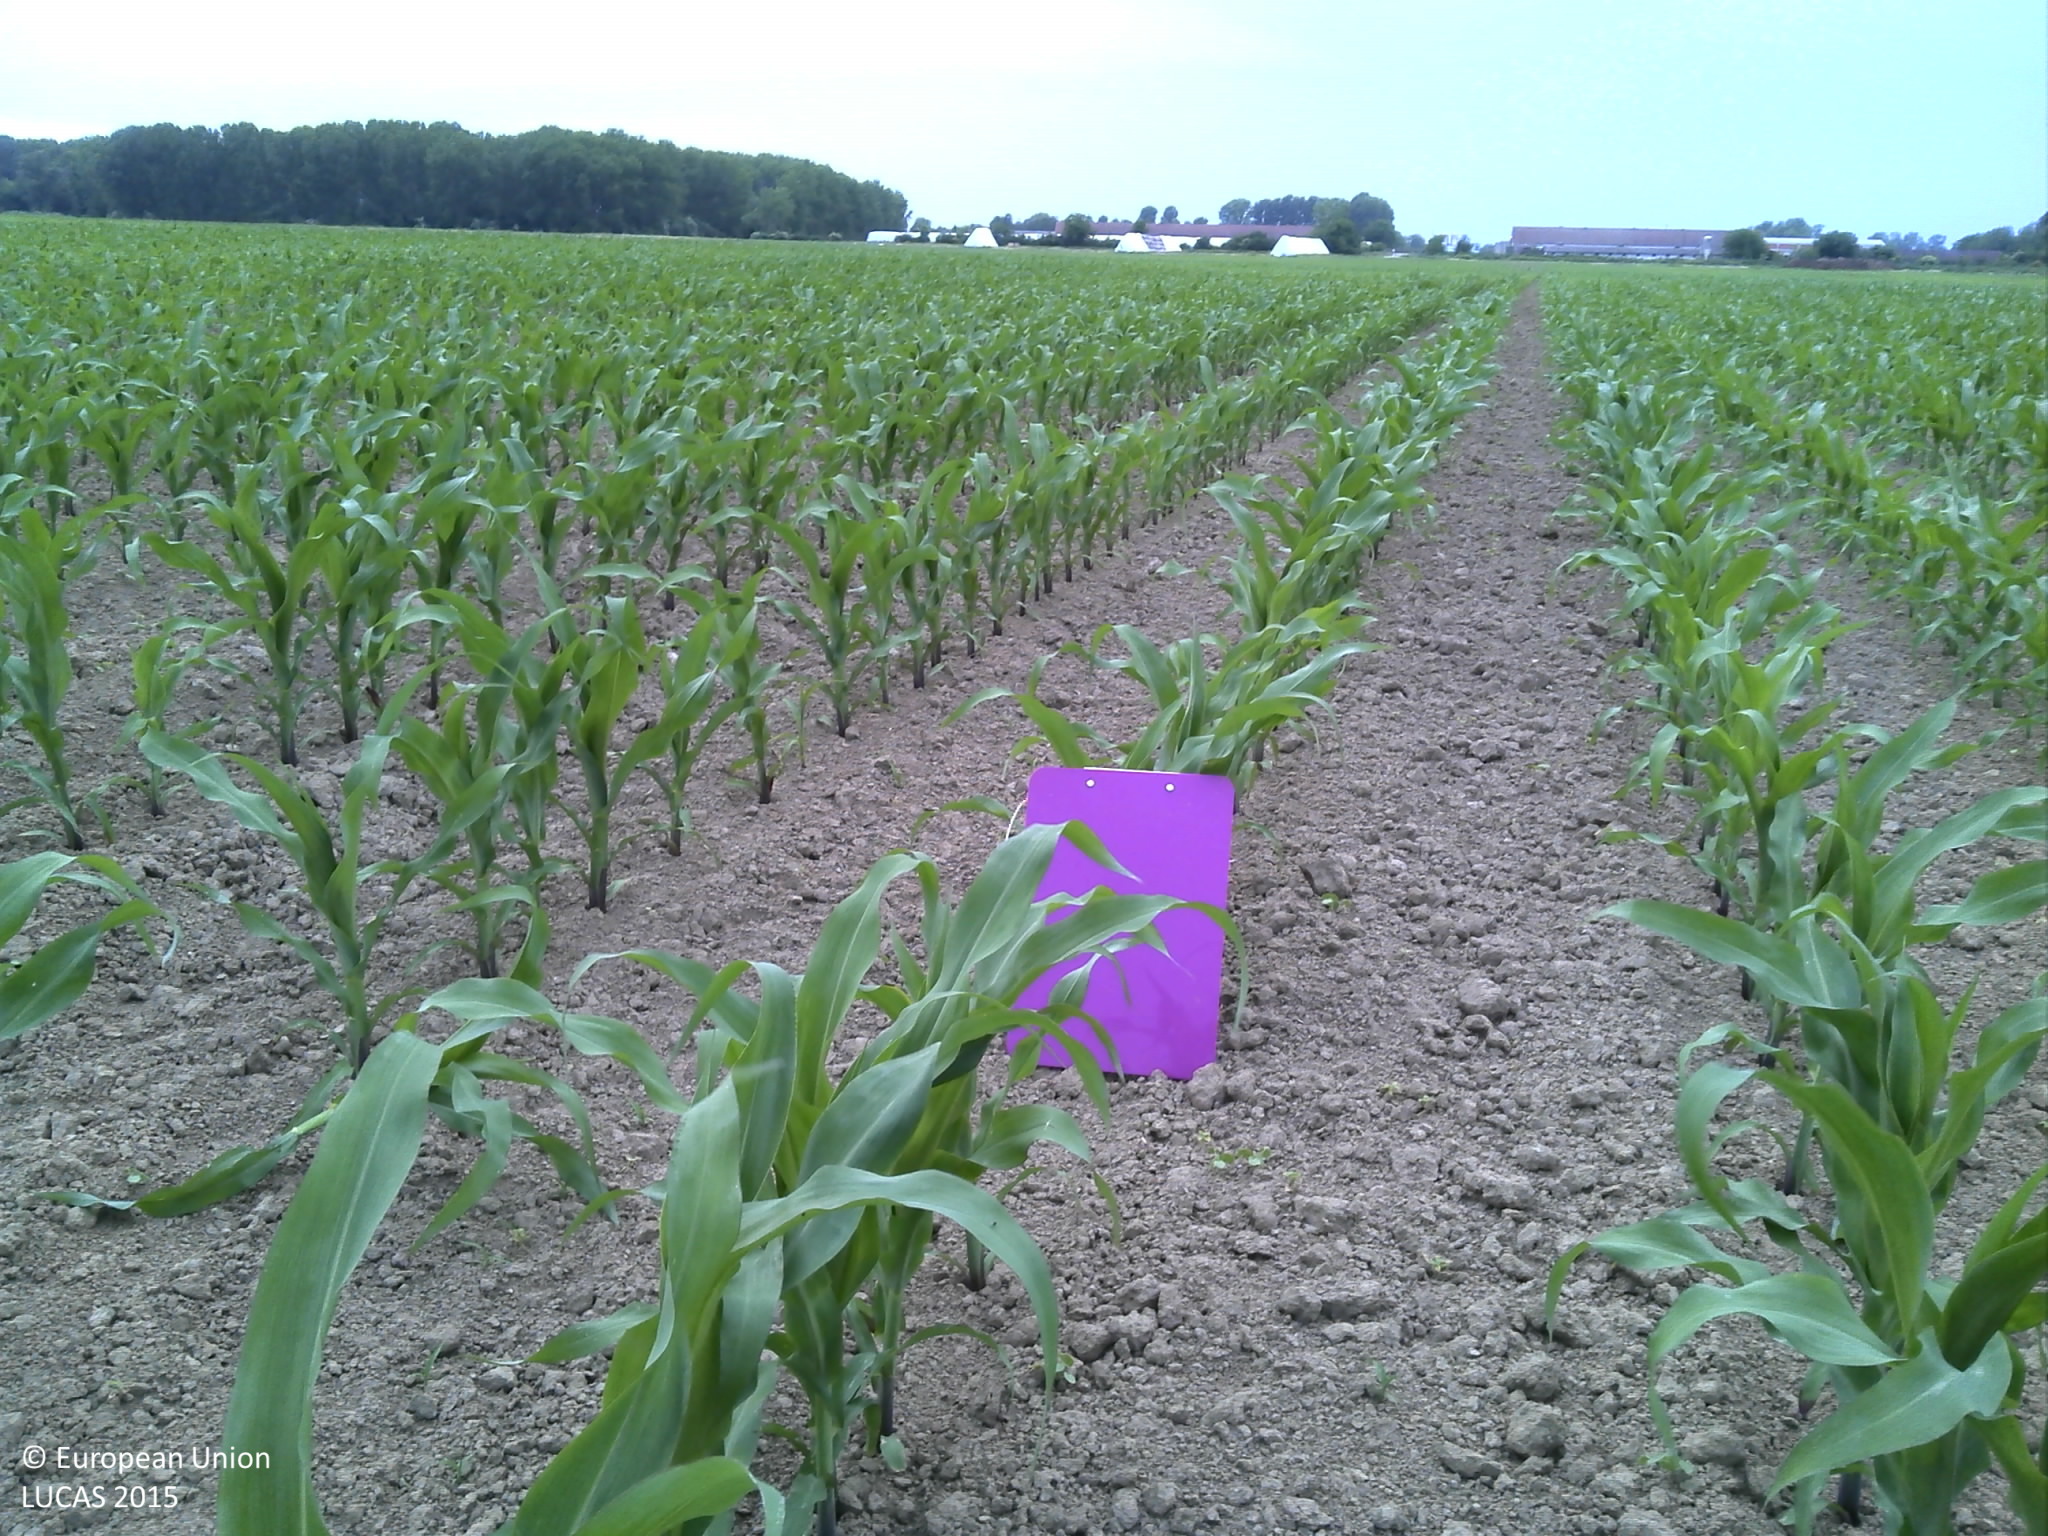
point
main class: Cropland
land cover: Maize
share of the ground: 25 - 50 %
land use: Agriculture (excluding fallow land and kitchen gardens)
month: May
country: HR
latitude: 45.5438
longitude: 18.4722
